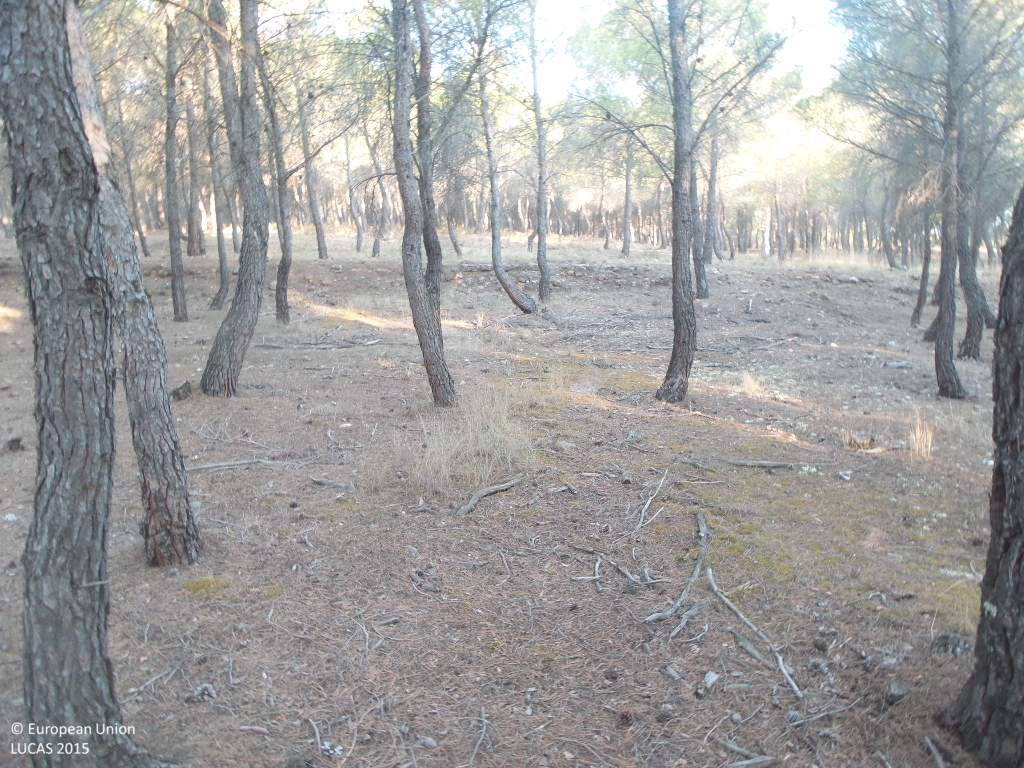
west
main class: Woodland
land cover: Pine dominated coniferous woodland
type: coniferous forest of the mediterranean region
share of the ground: > 75 %
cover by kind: coniferous forest trees 80 %, shrubs 10 %, lichens and mosses 10 %
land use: Semi-natural and natural areas not in use
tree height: > 5 m
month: July
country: ES
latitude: 41.2928
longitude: -2.0537
